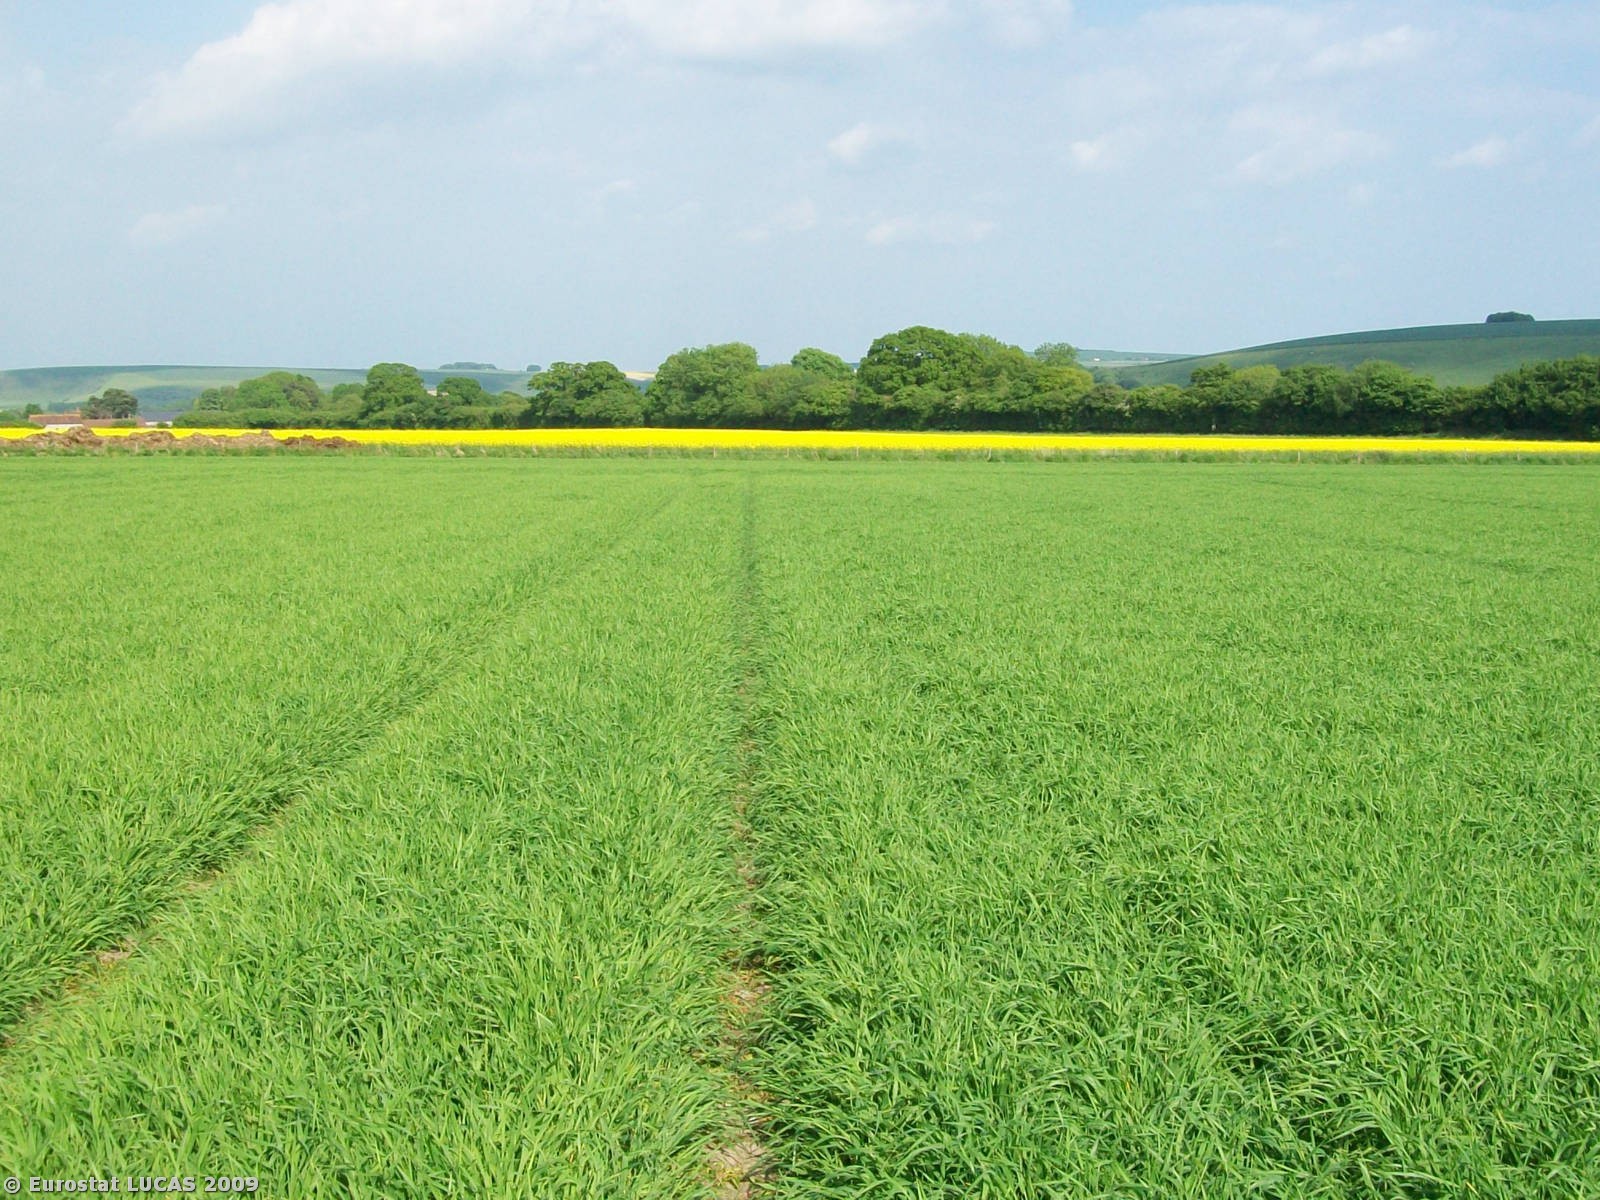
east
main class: Cropland
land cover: Barley
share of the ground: > 75 %
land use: Agriculture (excluding fallow land and kitchen gardens)
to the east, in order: Barley; Grass margins; Fences; Grassland without tree/shrub cover; Rape and turnip rape
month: May
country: GB
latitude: 51.1600
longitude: -2.2305
